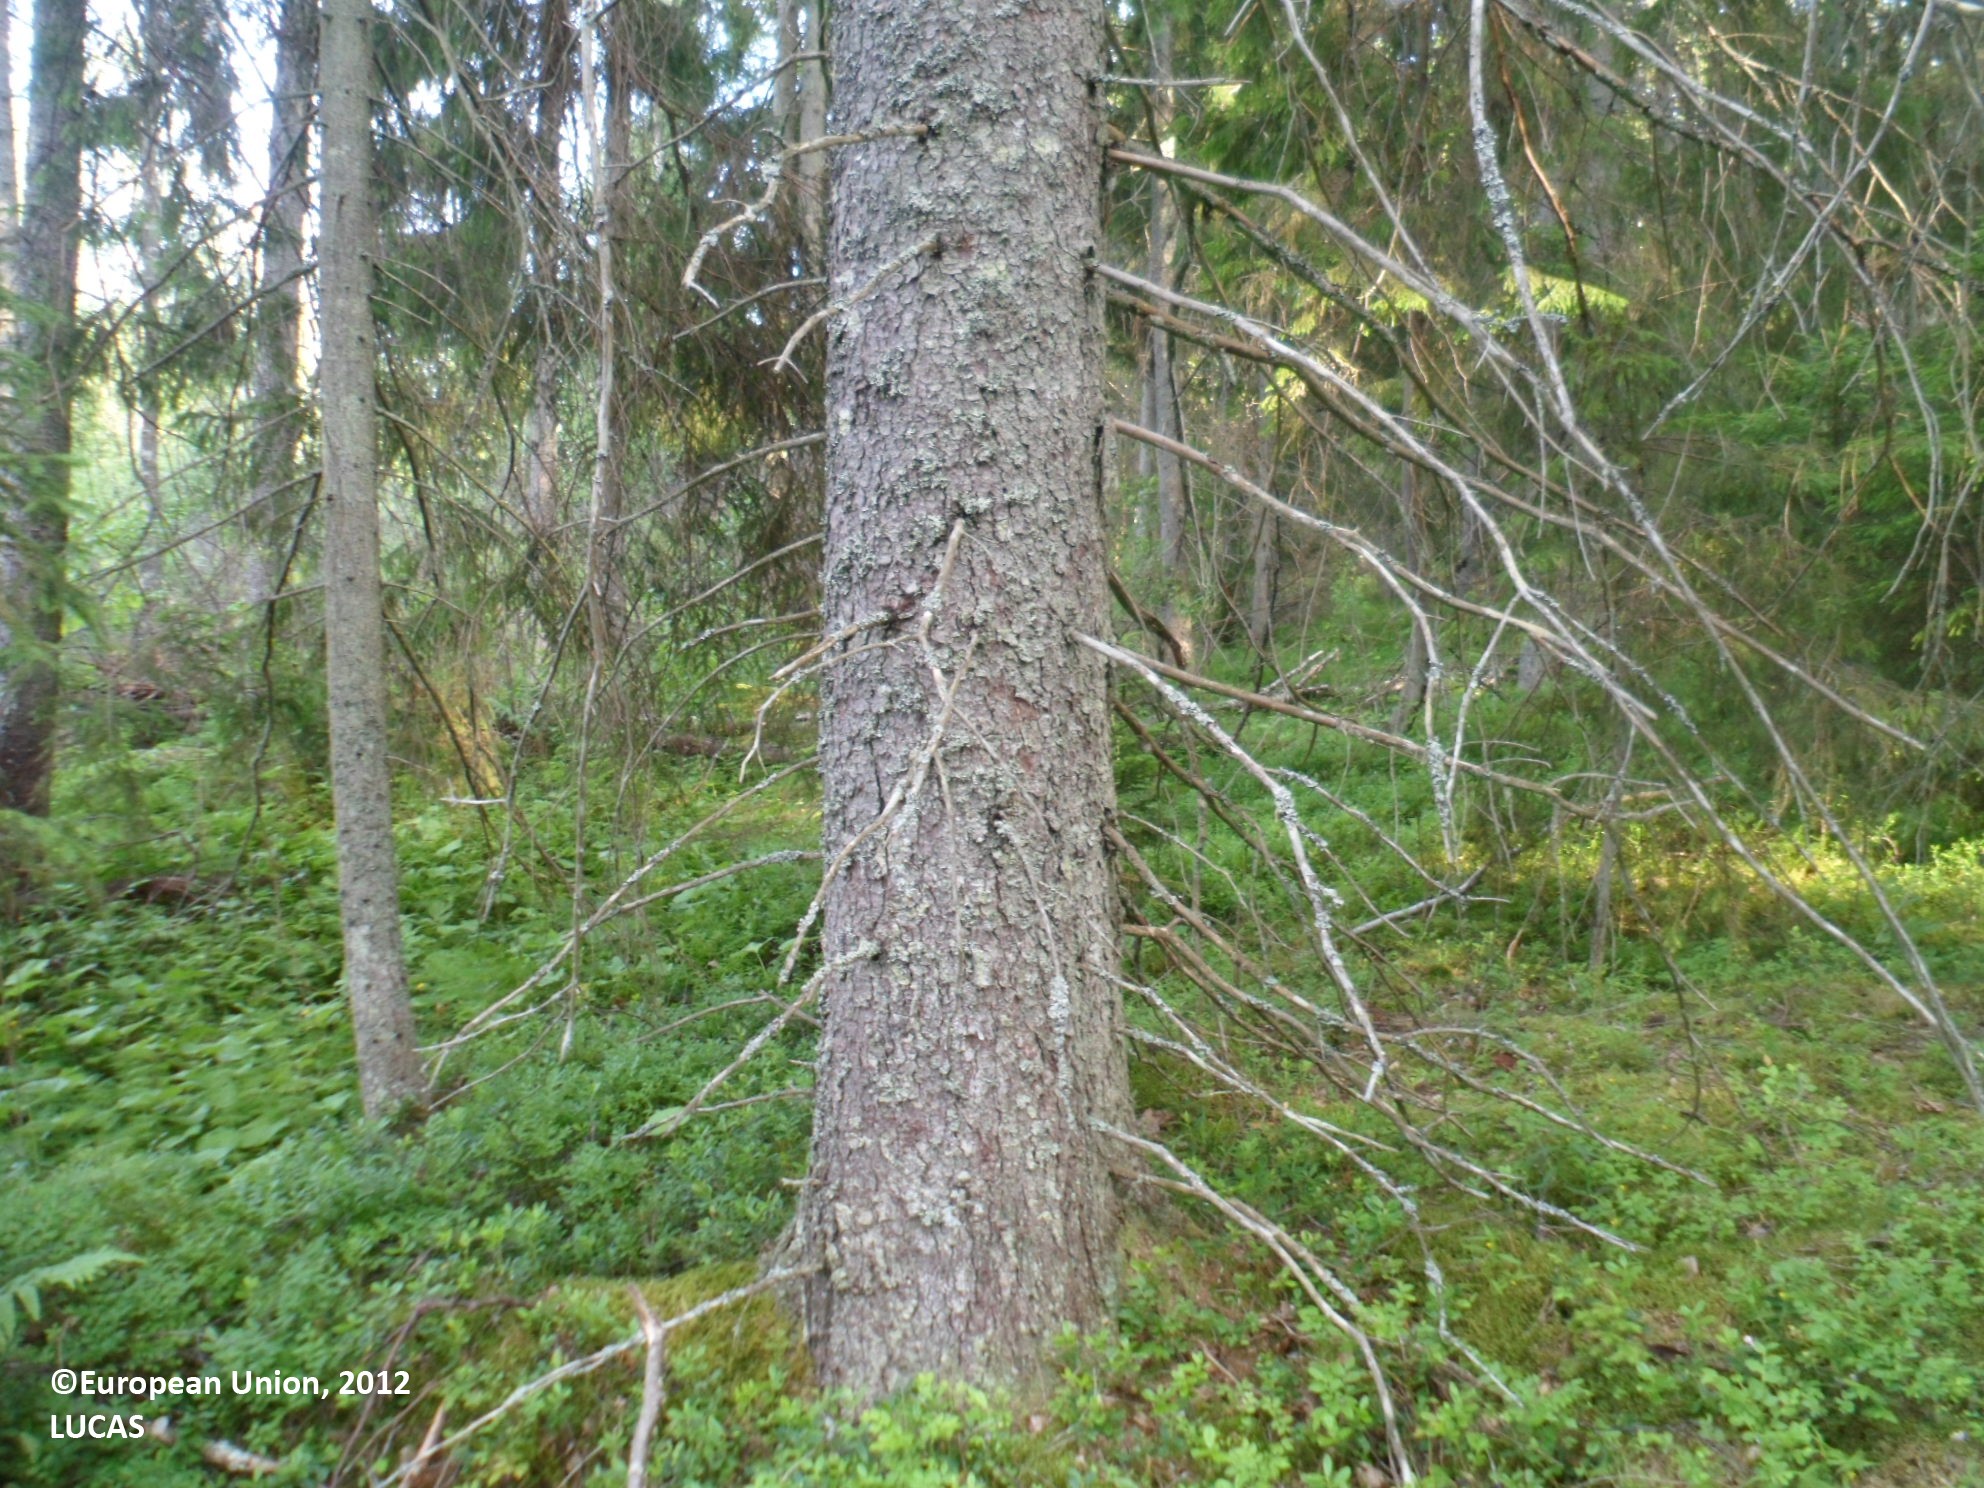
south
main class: Woodland
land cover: Spruce dominated coniferous woodland
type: boreal forest
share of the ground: > 75 %
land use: Forestry
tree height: > 5 m
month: July
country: SE
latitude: 59.6457
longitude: 18.6043
